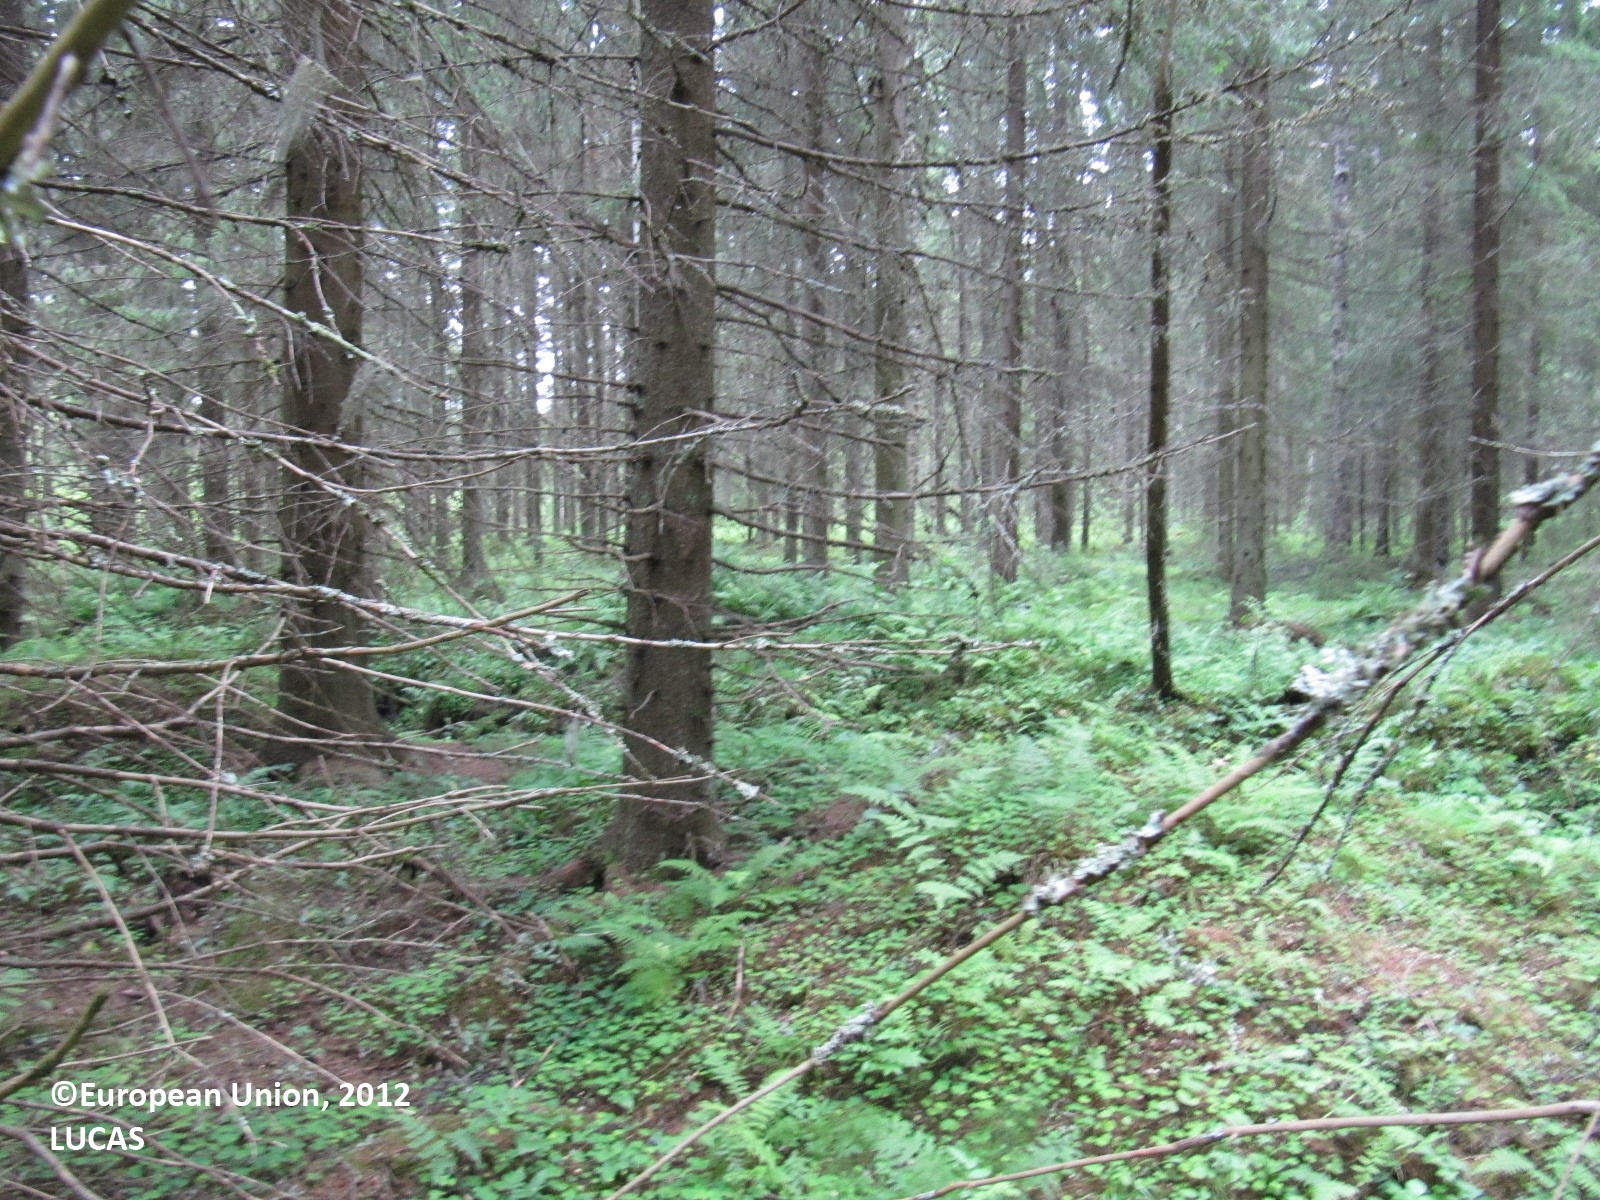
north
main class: Woodland
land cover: Spruce dominated coniferous woodland
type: boreal forest
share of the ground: > 75 %
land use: Forestry
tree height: > 5 m
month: July
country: FI
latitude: 60.9889
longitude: 24.6531
